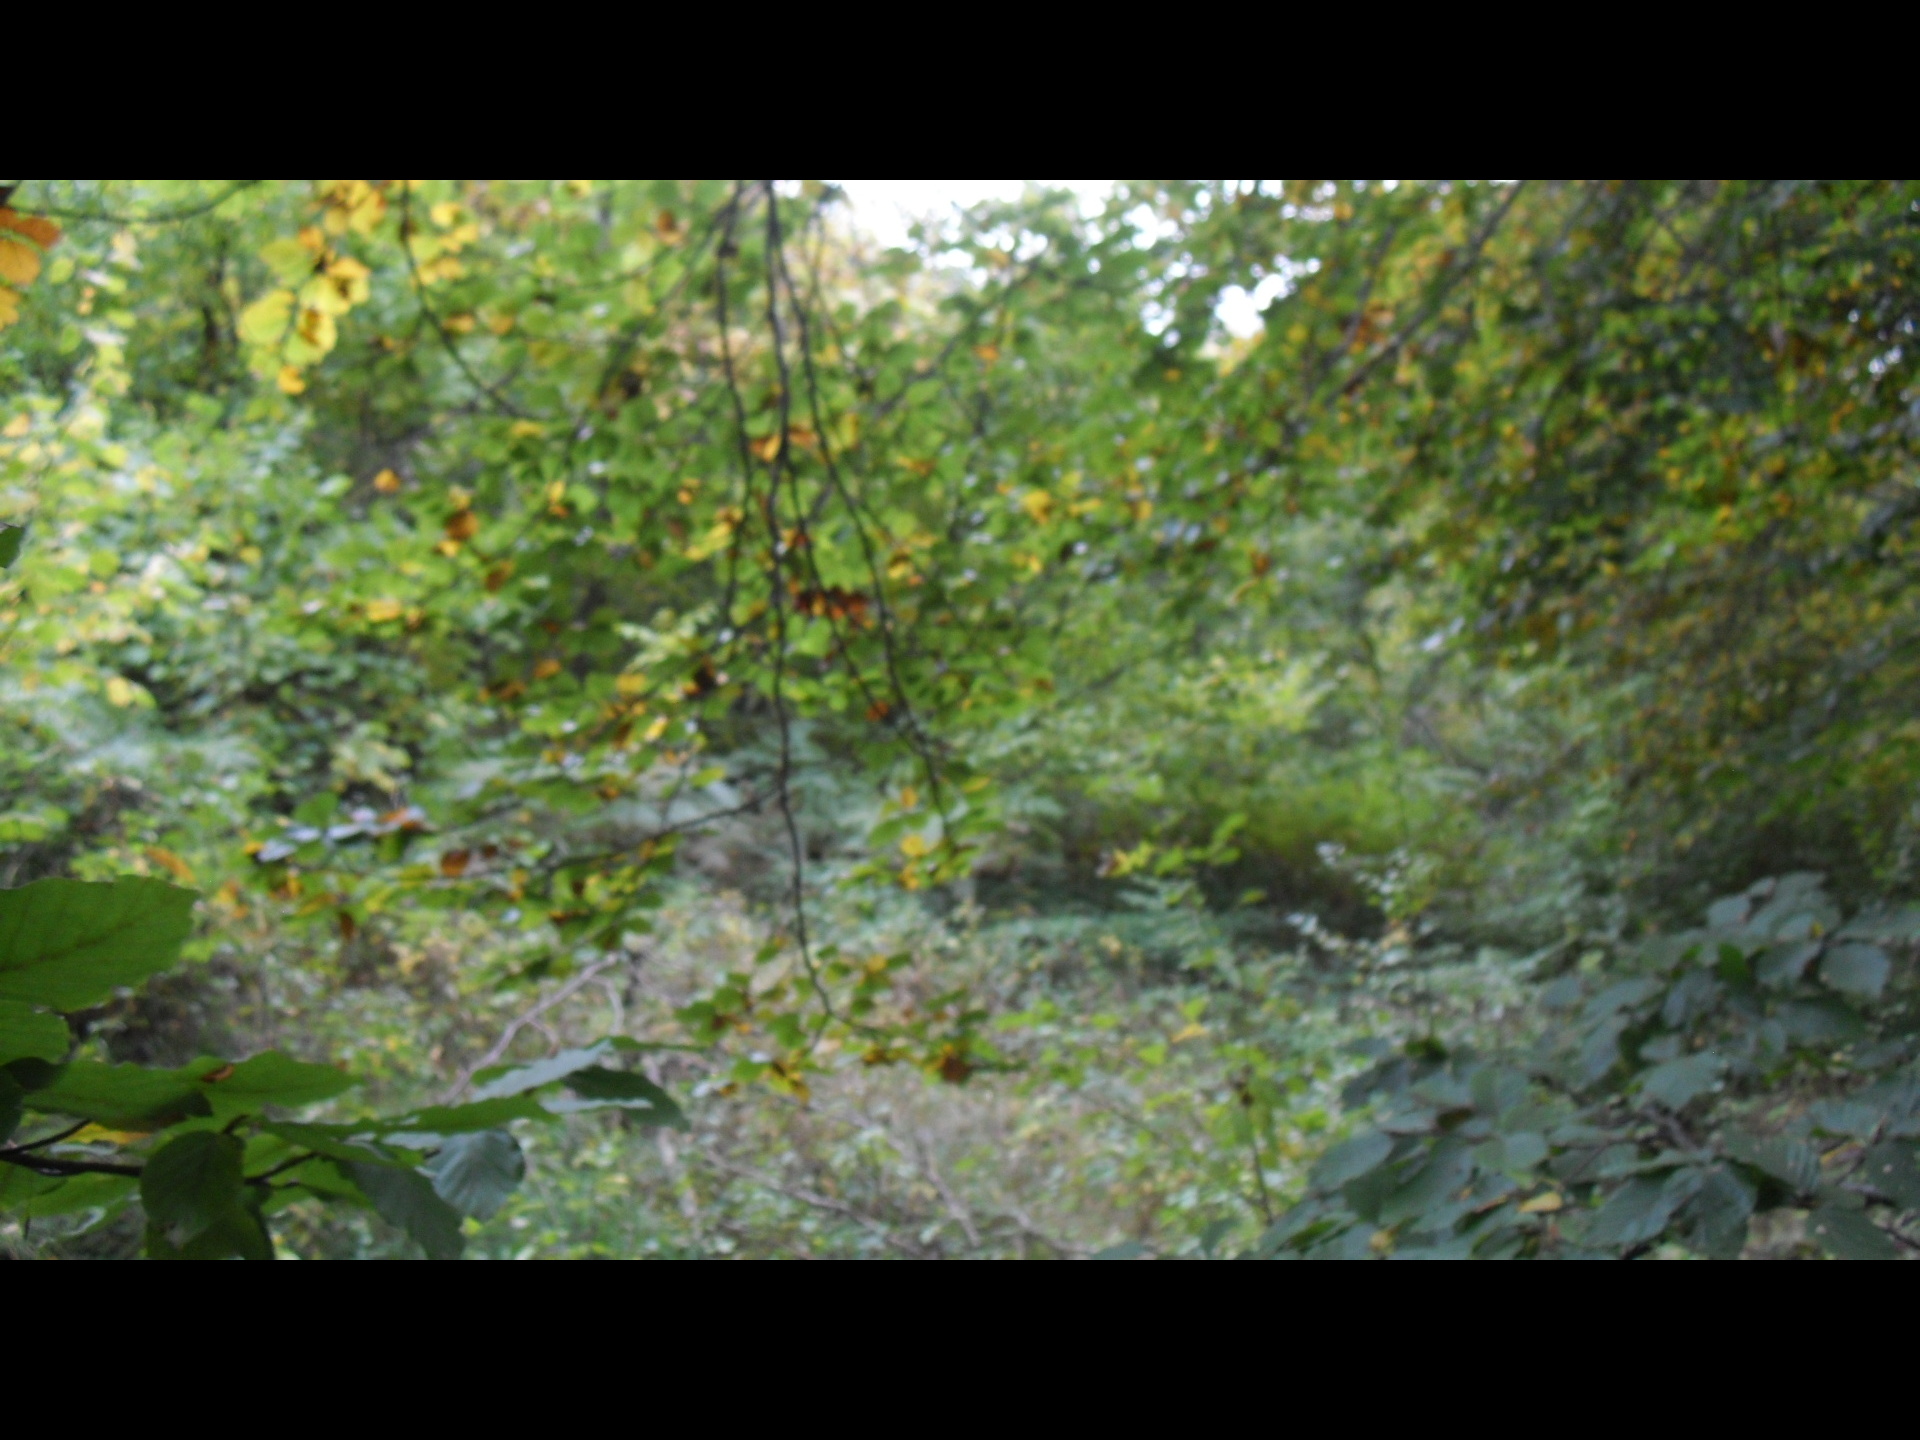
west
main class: Woodland
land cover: Broadleaved woodland
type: mesophytic deciduous forest
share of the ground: > 75 %
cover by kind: broadleaved forest trees 95 %, shrubs 5 %
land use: Forestry
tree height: > 5 m
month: October
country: BG
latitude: 43.5109
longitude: 22.5618
